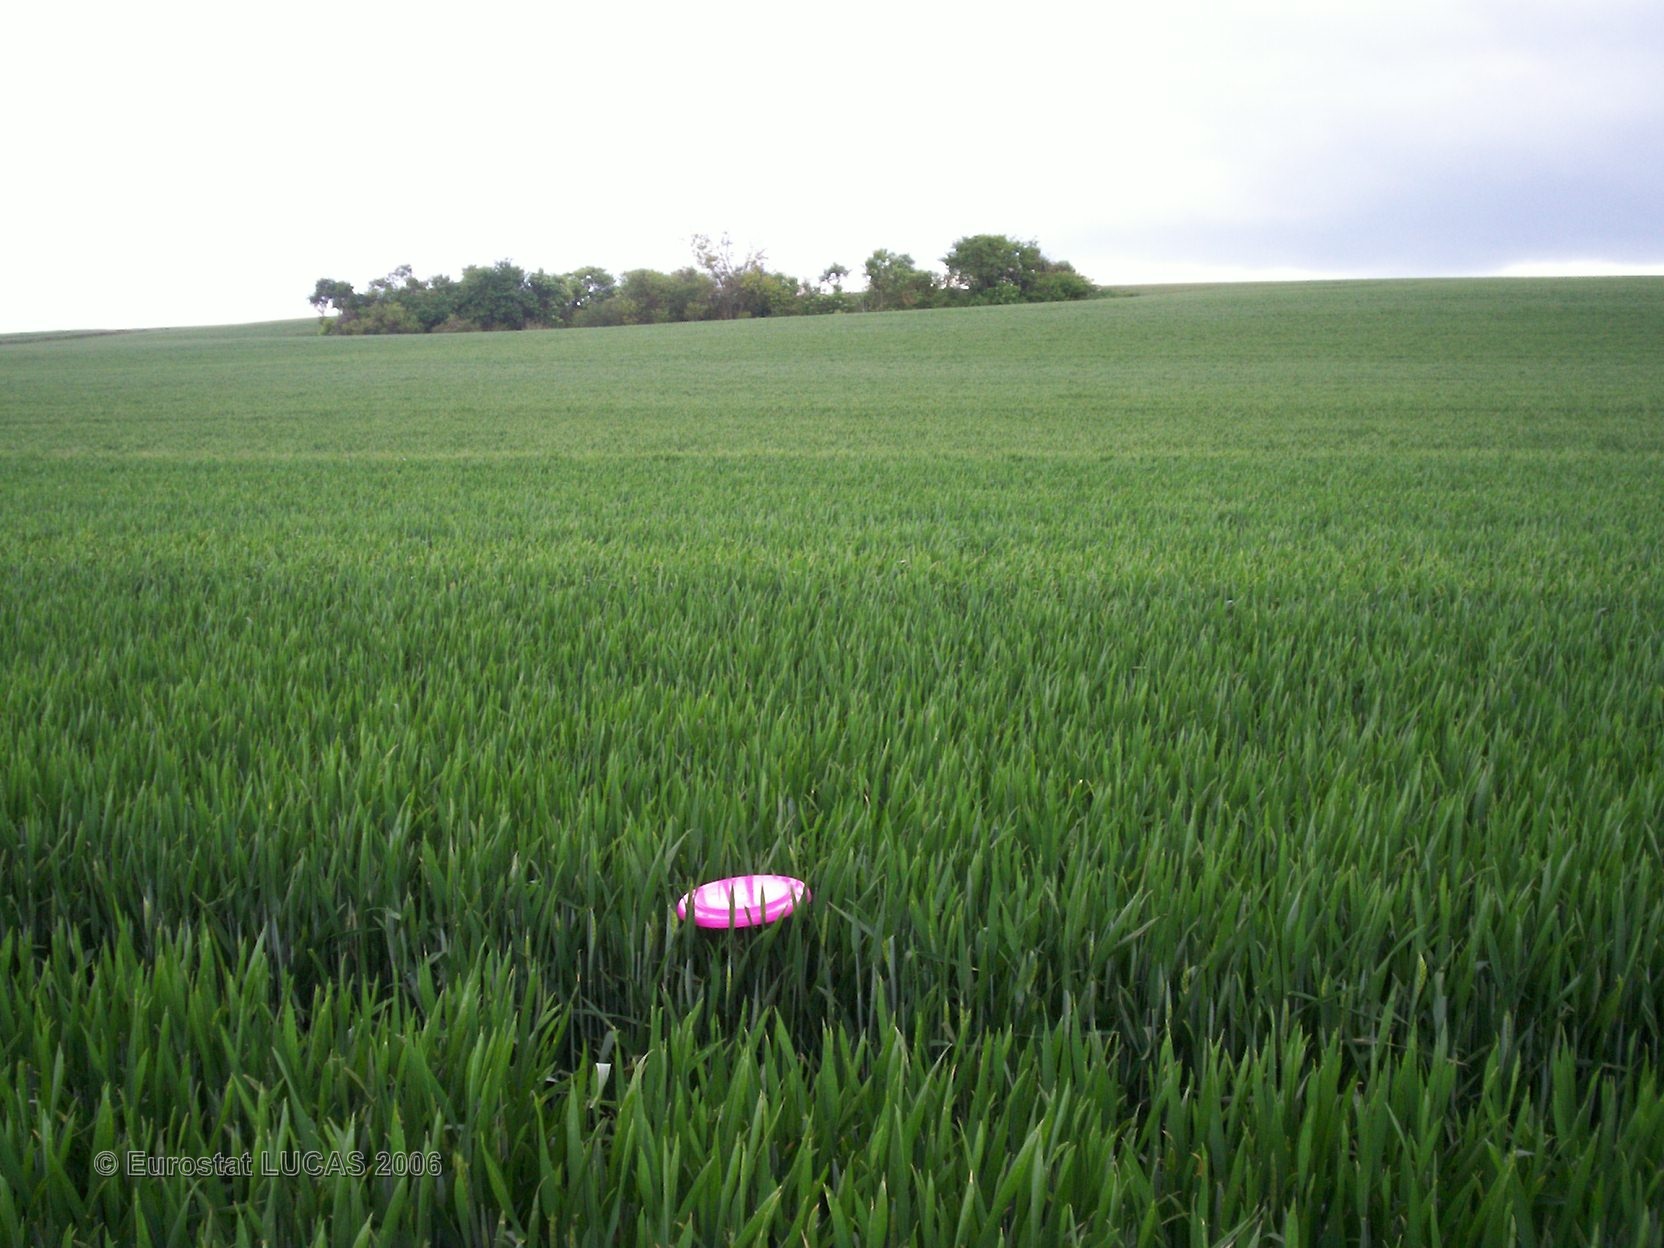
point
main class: Cropland
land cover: Common wheat
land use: Agriculture (excluding fallow land and kitchen gardens)
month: May
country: FR
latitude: 49.2890
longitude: 3.7106
